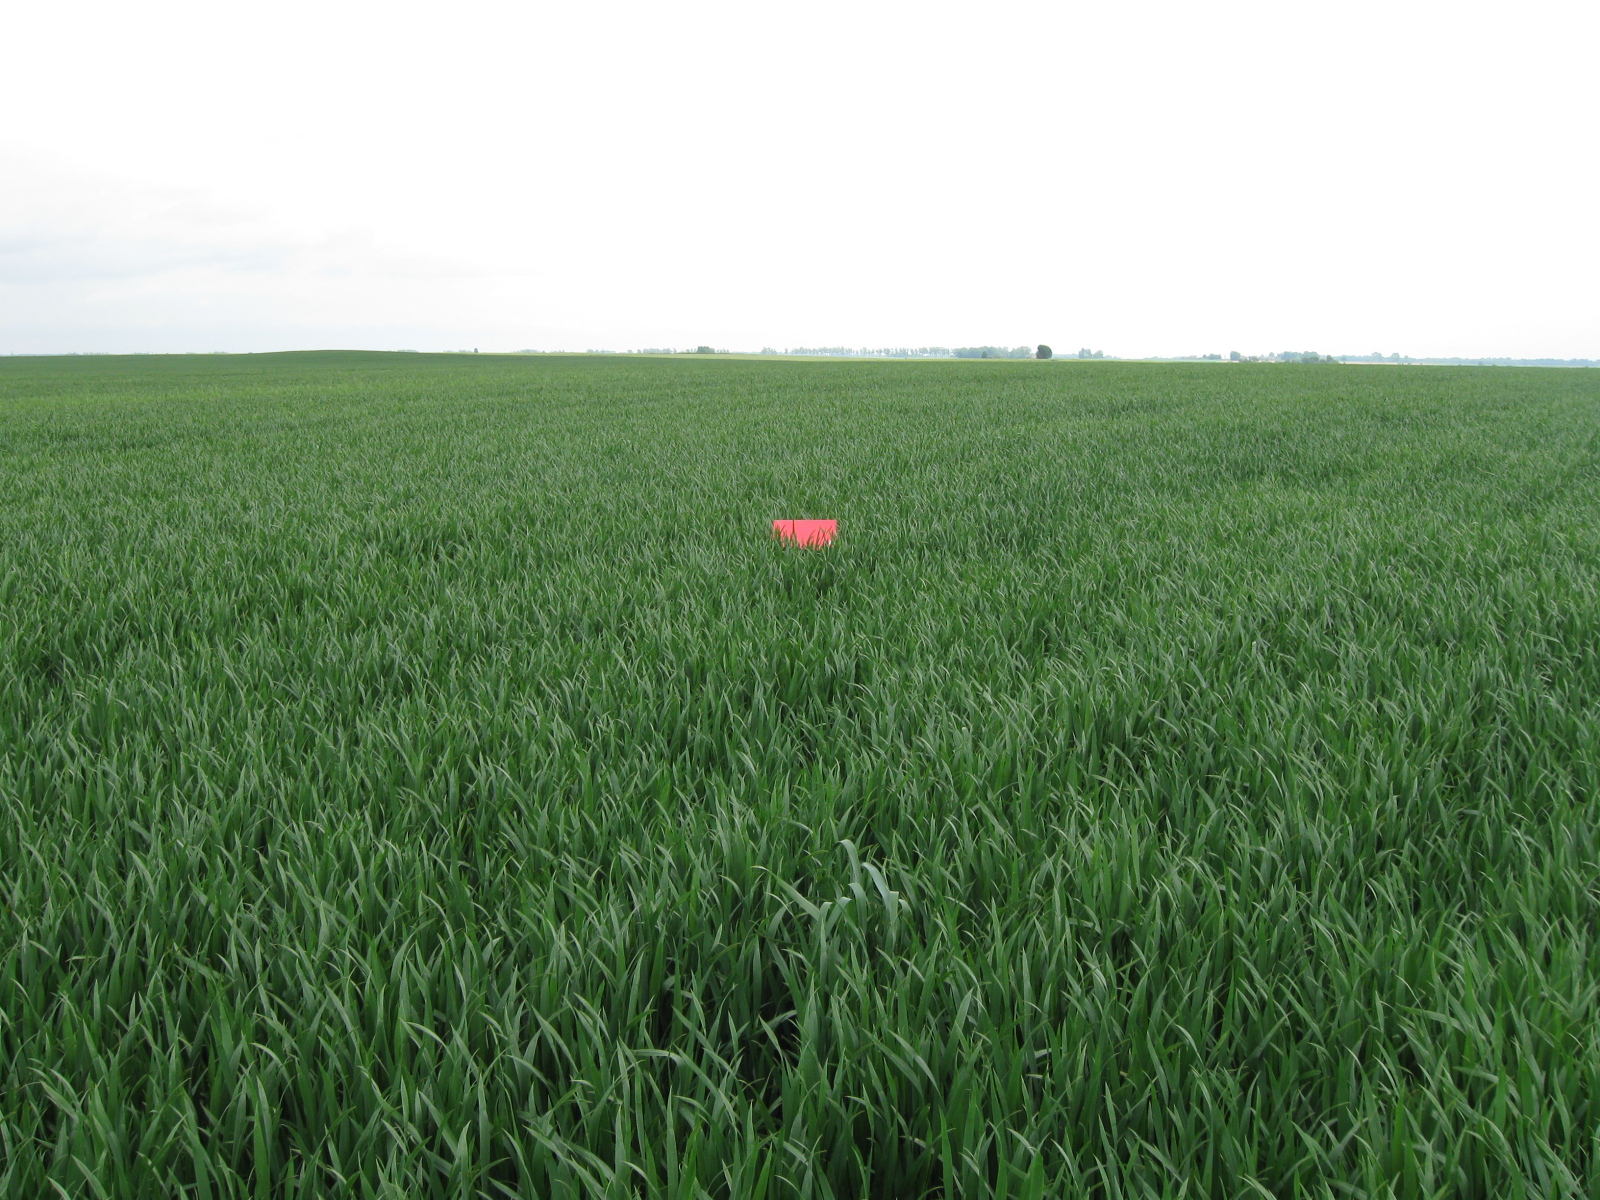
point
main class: Cropland
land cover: Common wheat
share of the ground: > 75 %
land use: Agriculture (excluding fallow land and kitchen gardens)
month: May
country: LT
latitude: 54.6831
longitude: 22.8345
